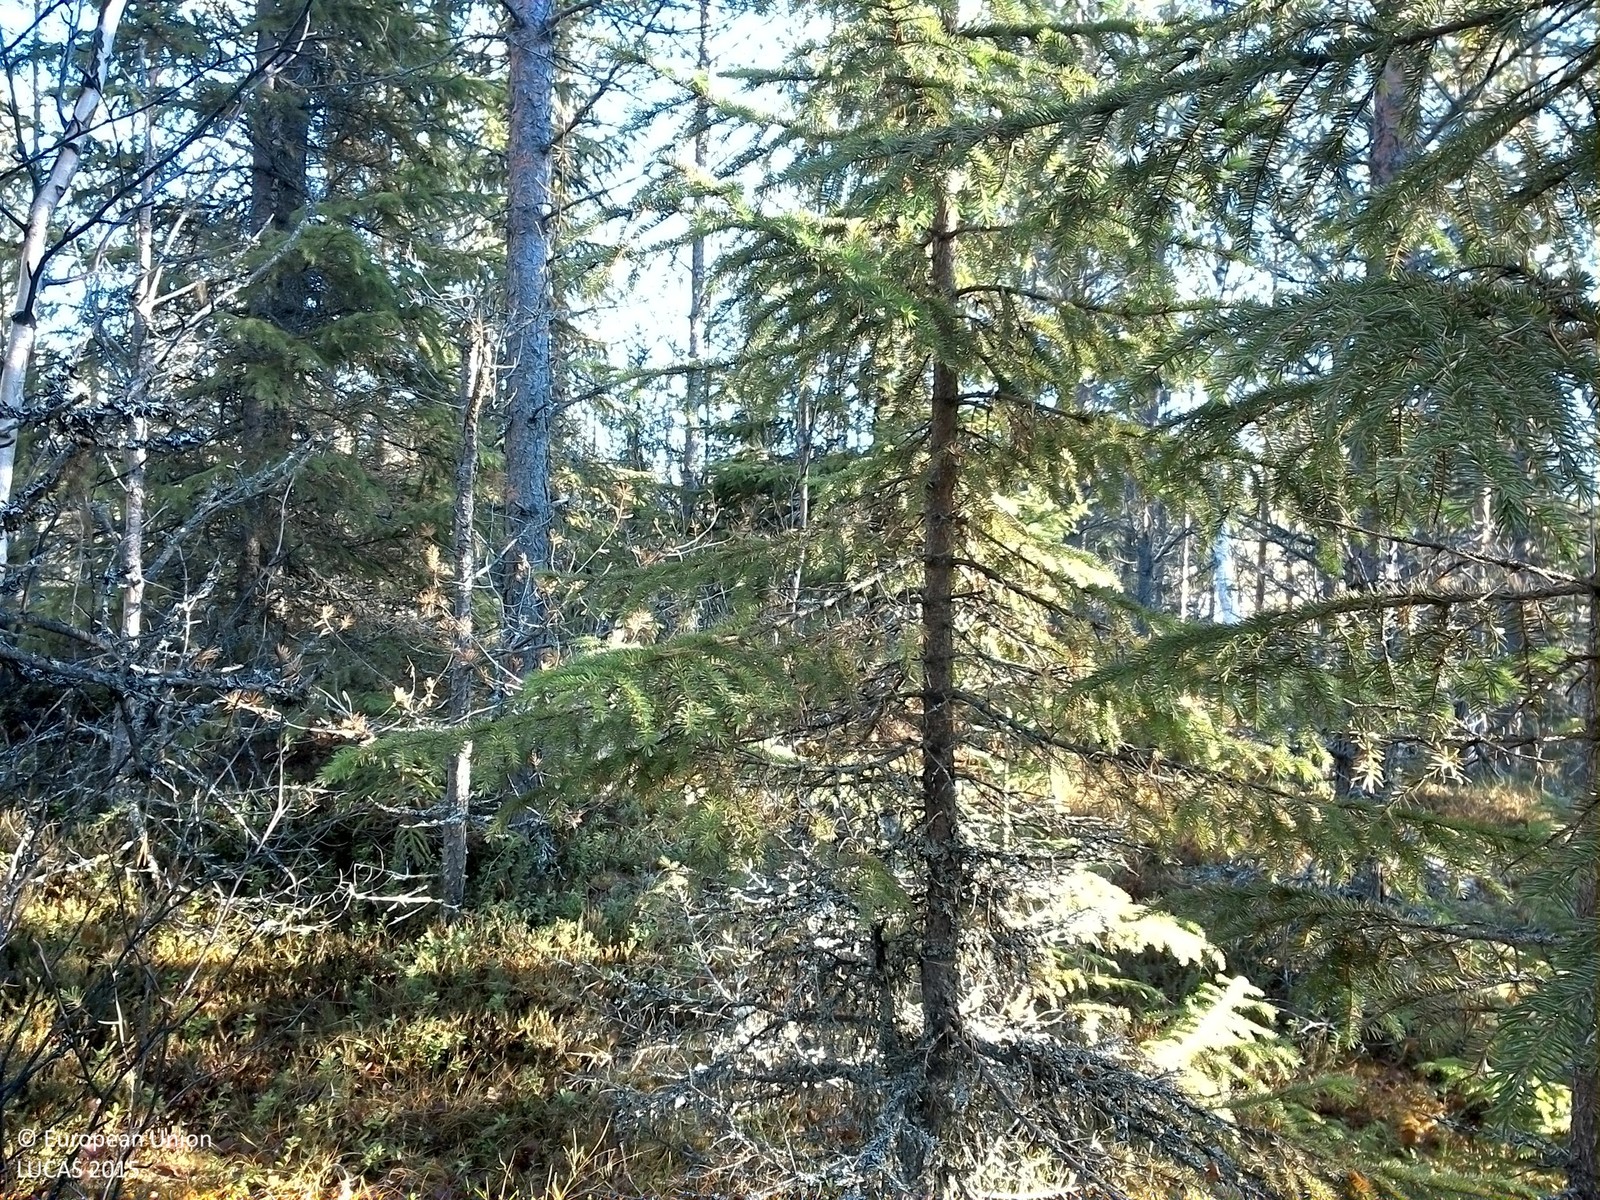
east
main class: Woodland
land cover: Pine dominated coniferous woodland
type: boreal forest
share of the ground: 50 - 75 %
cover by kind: coniferous forest trees 45 %, shrubs 30 %, lichens and mosses 15 %, broadleaved forest trees 10 %
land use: Forestry
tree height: > 5 m
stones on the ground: 10 - 25 %
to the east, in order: Pine dominated coniferous woodland; Pine dominated mixed woodland; Spruce dominated mixed woodland; Pine dominated coniferous woodland
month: October
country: SE
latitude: 63.7658
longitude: 15.8330
